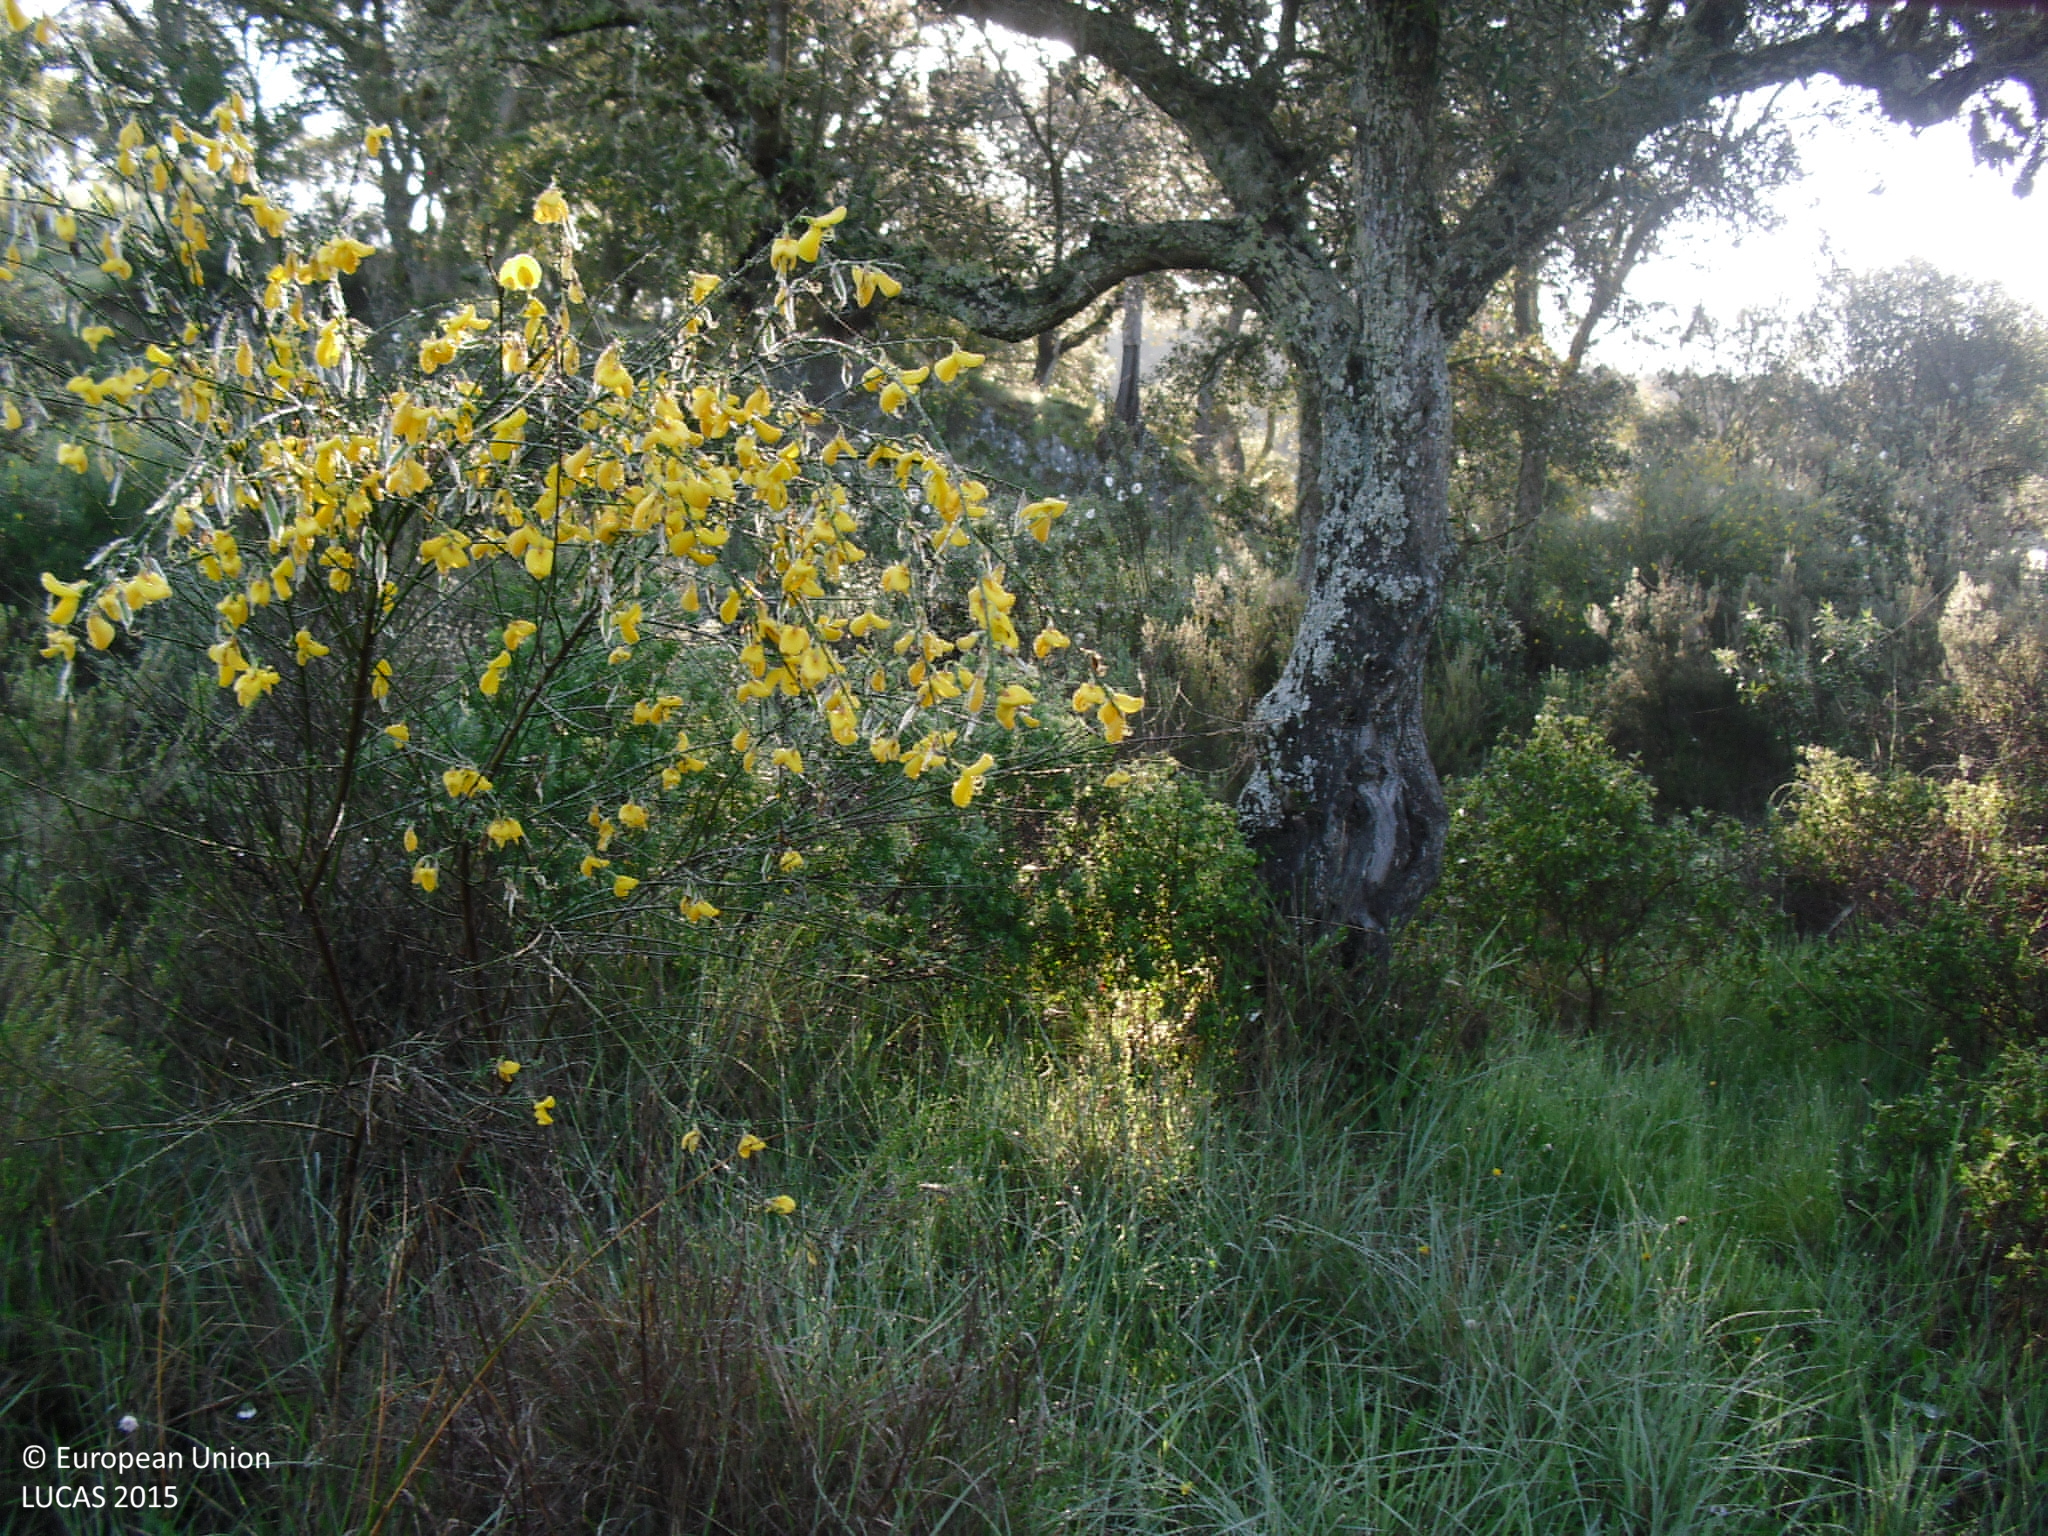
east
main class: Woodland
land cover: Broadleaved woodland
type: broadleaved evergreen forest
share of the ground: 25 - 50 %
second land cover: Grassland without tree/shrub cover
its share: > 75 %
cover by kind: herbaceous plants 60 %, broadleaved forest trees 30 %, shrubs 10 %
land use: Forestry
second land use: Agriculture (excluding fallow land and kitchen gardens)
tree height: > 5 m
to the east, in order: Broadleaved woodland; Grassland without tree/shrub cover; Fences; Broadleaved woodland; Electric lines; Broadleaved woodland; Dry stone walls; Shrubland with sparse tree cover; Fences; Other structural elements; Broadleaved woodland
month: April
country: ES
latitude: 39.6418
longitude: -7.4931
